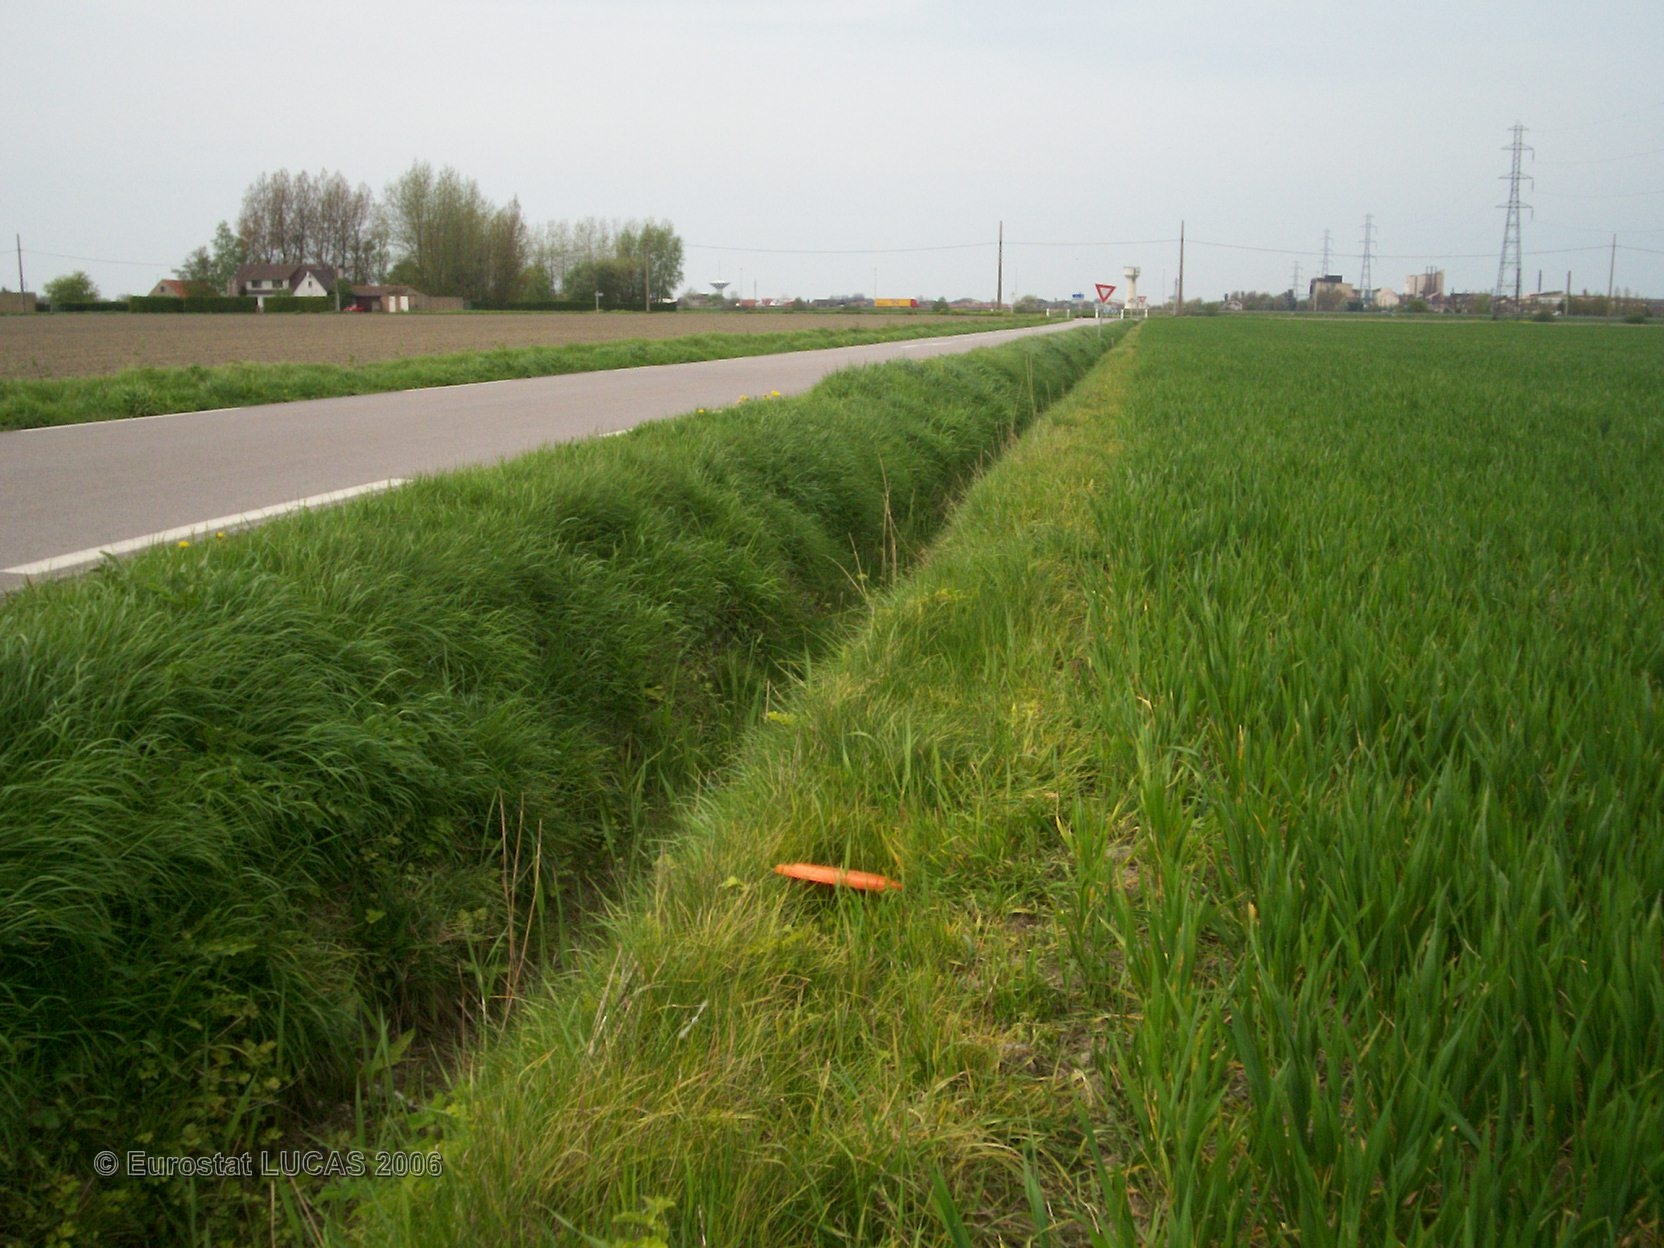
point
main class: Cropland
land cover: Common wheat
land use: Agriculture (excluding fallow land and kitchen gardens)
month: May
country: FR
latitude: 51.0368
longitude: 2.4715
